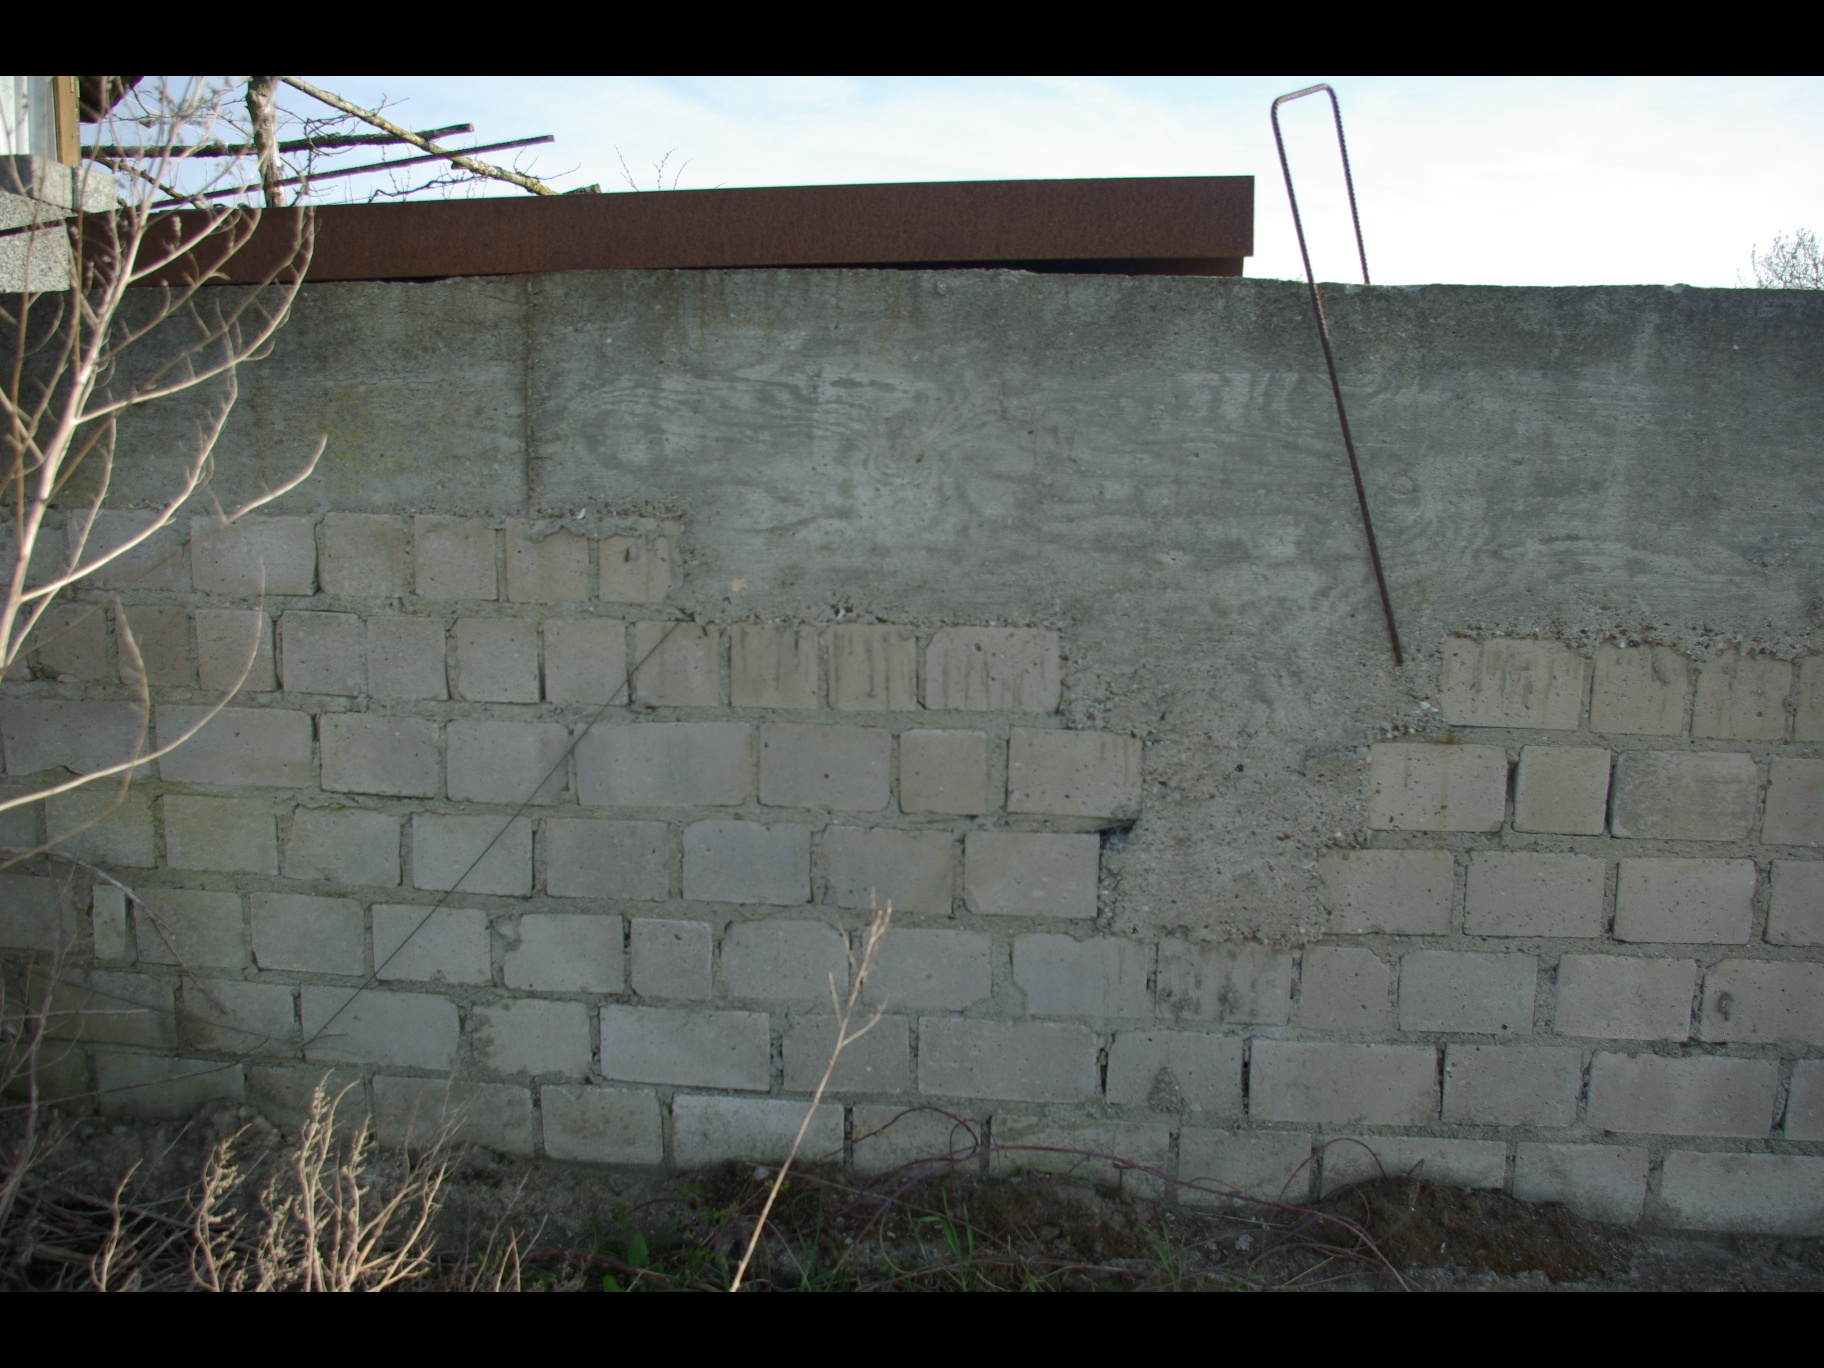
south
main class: Grassland
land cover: Spontaneously vegetated surfaces
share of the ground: > 75 %
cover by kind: herbaceous plants 100 %
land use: Residential
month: May
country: DE
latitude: 54.4386
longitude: 11.1865
